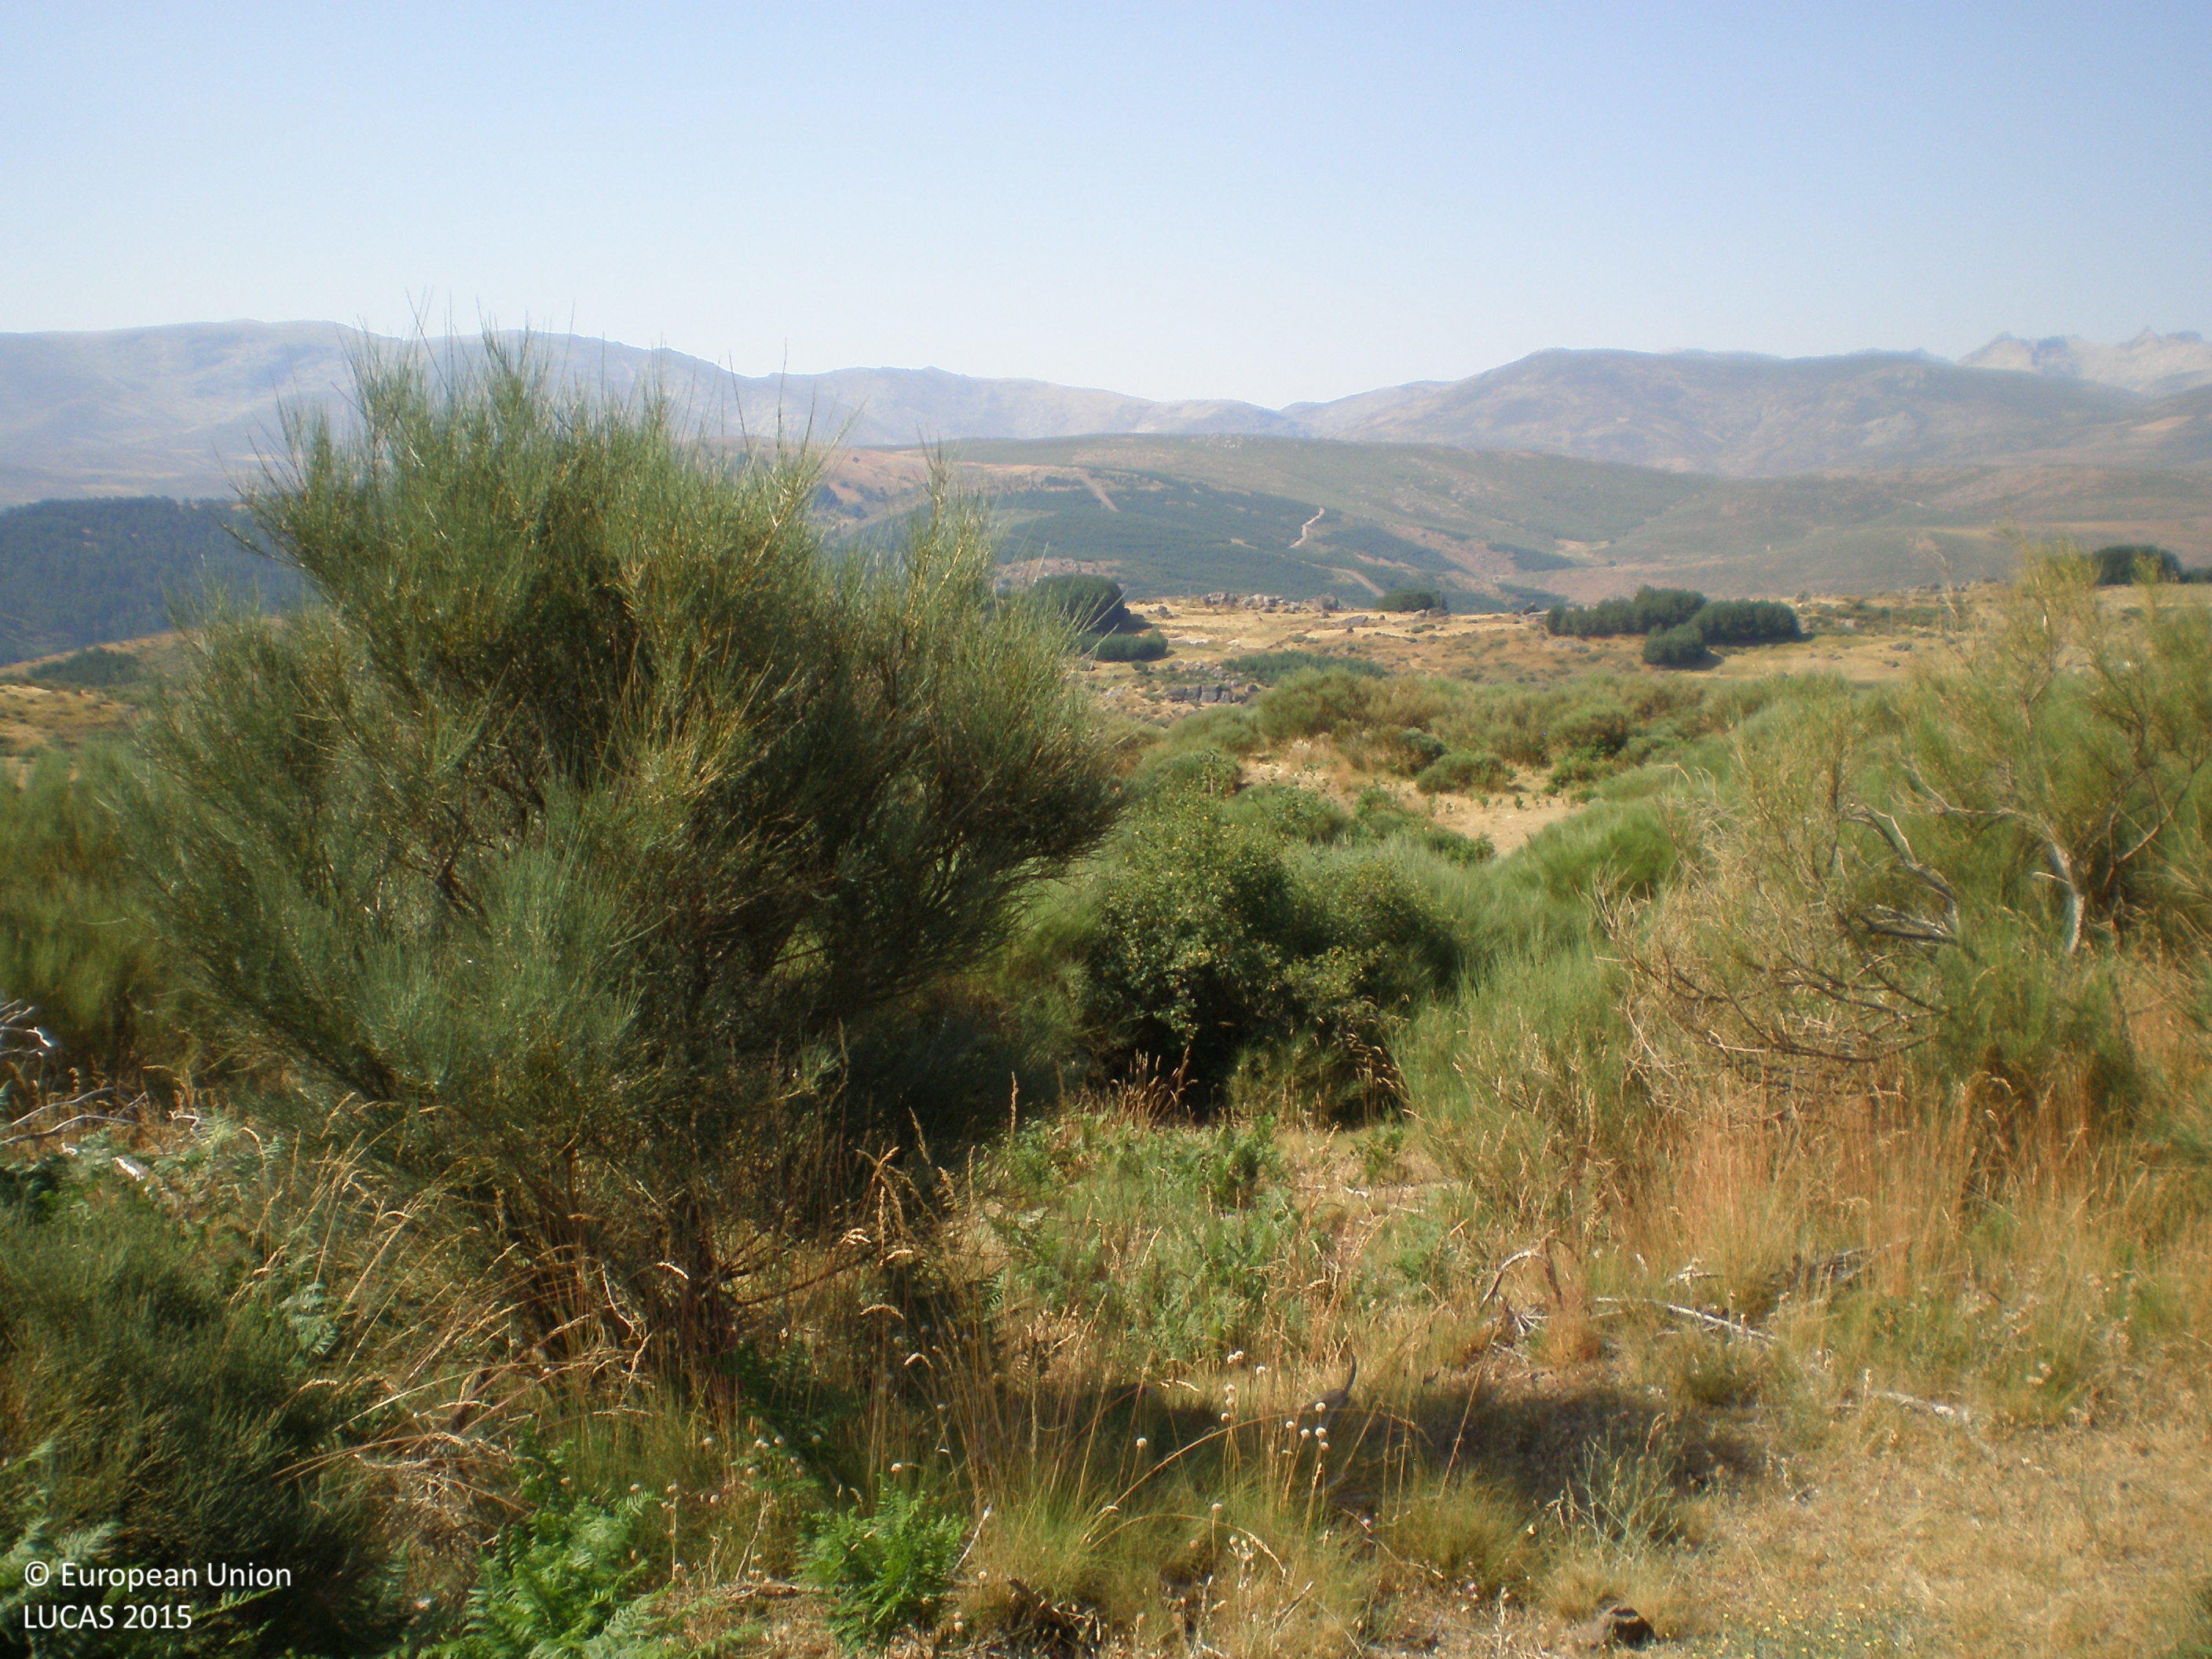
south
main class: Shrubland
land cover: Shrubland without tree cover
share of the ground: 50 - 75 %
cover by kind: shrubs 70 %, herbaceous plants 30 %
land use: Semi-natural and natural areas not in use
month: July
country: ES
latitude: 40.3624
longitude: -5.1916
